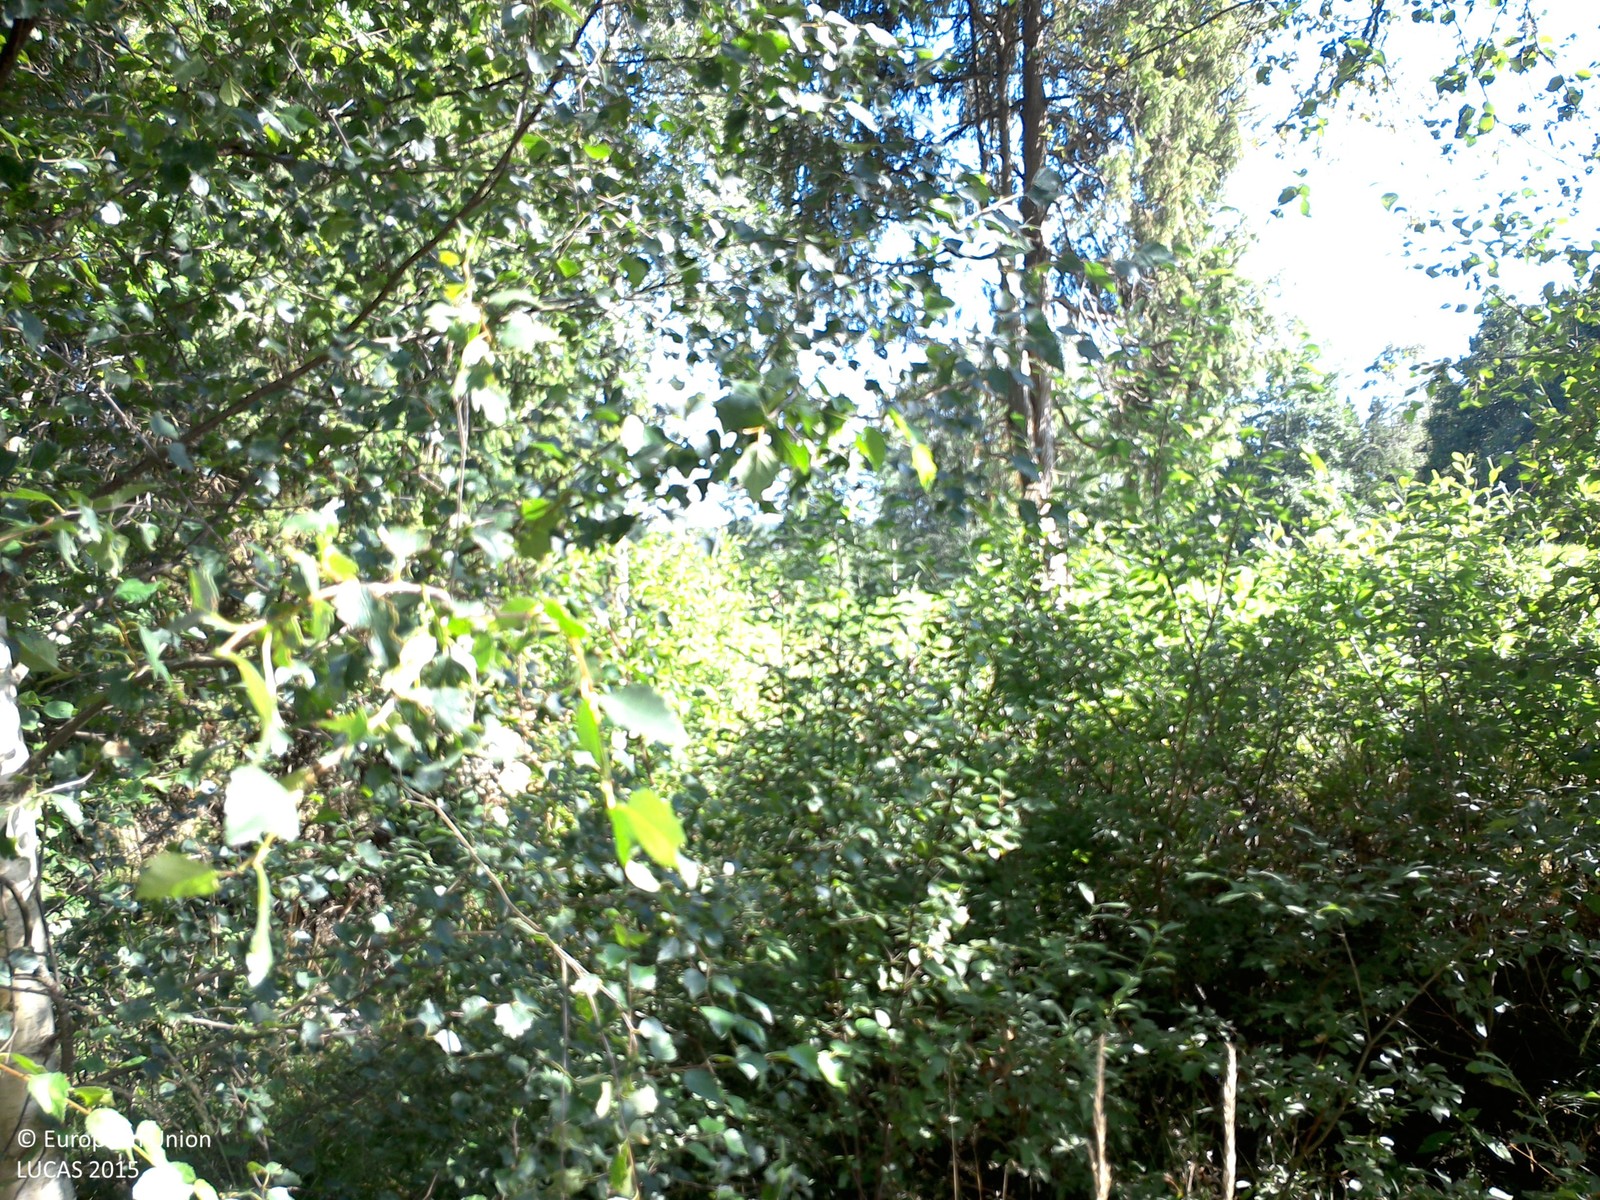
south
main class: Woodland
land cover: Broadleaved woodland
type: boreal forest
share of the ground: 50 - 75 %
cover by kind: broadleaved forest trees 55 %, herbaceous plants 40 %, coniferous forest trees 5 %
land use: Forestry
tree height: > 5 m
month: August
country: SE
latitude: 57.9604
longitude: 15.5560
